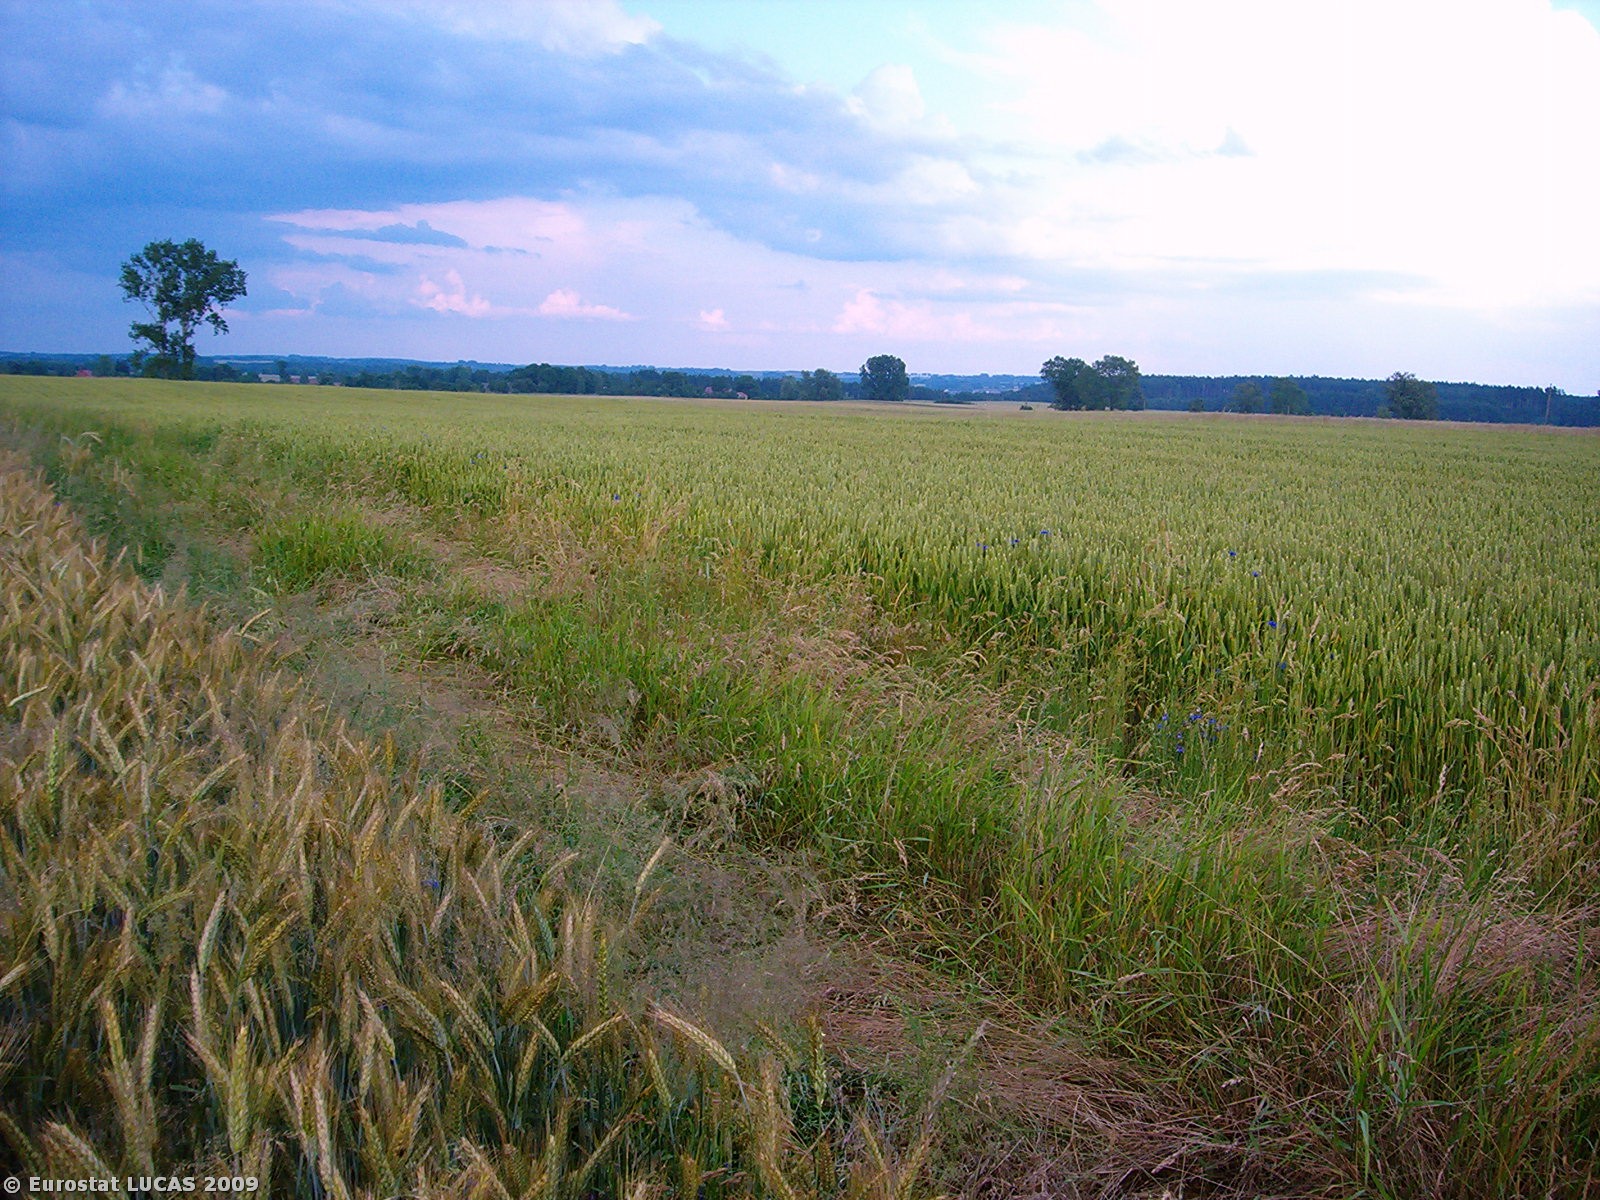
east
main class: Cropland
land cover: Triticale
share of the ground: > 75 %
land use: Agriculture (excluding fallow land and kitchen gardens)
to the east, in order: Triticale; Tracks; Common wheat; Grass margins; Common wheat
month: July
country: PL
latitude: 53.2601
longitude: 15.4751
